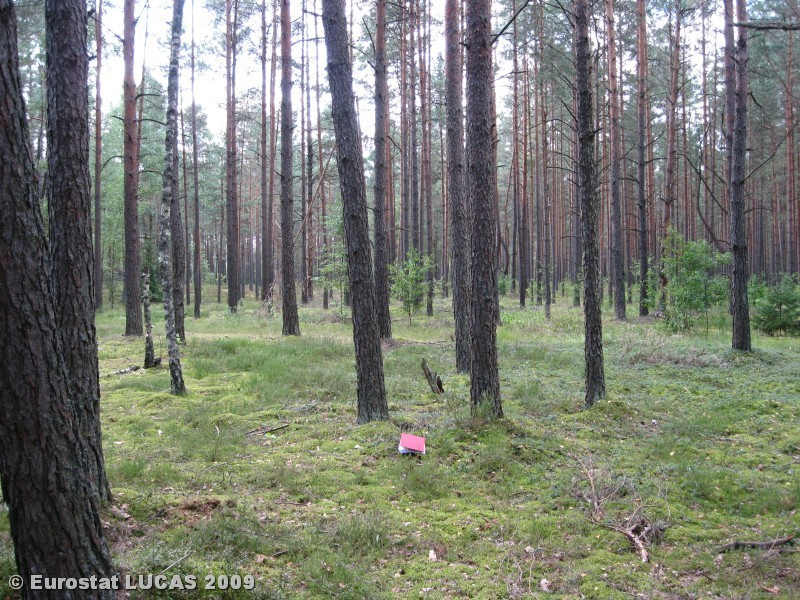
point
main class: Woodland
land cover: Coniferous woodland
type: hemiboreal forest and nemoral coniferous forest and mixed broadleaved-coniferous forest
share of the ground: > 75 %
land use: Forestry
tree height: > 5 m
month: August
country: LT
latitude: 54.8963
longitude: 23.5700
